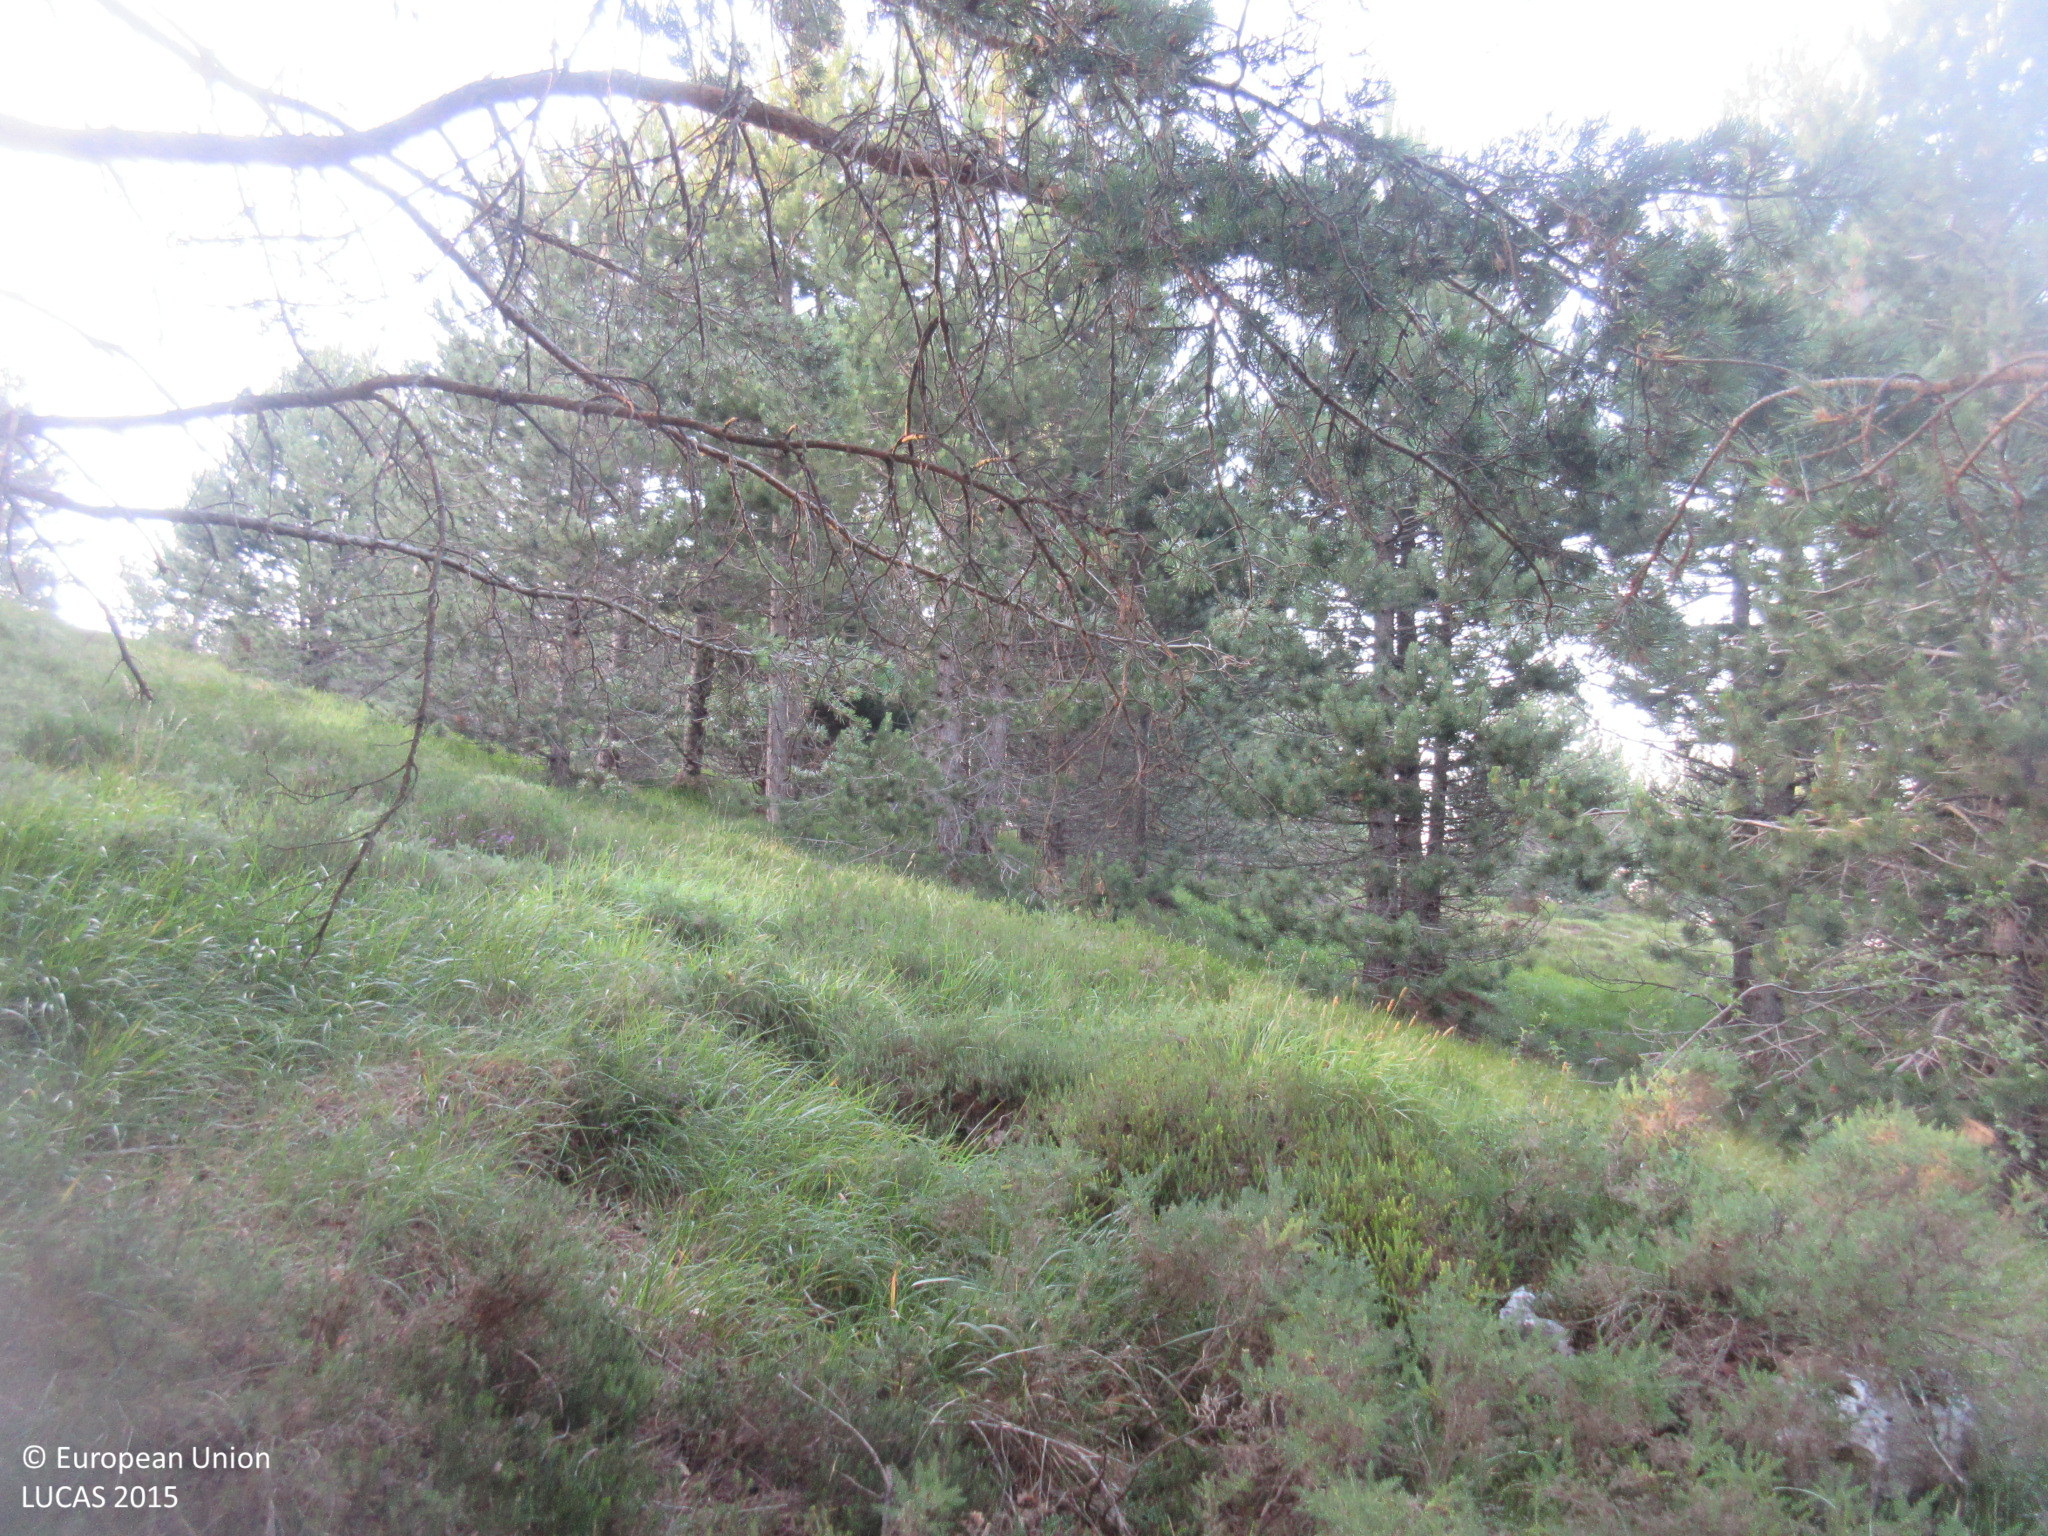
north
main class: Woodland
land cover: Pine dominated coniferous woodland
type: hemiboreal forest and nemoral coniferous forest and mixed broadleaved-coniferous forest
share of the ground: > 75 %
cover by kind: coniferous forest trees 90 %, shrubs 10 %
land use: Forestry
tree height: > 5 m
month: July
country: ES
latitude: 43.0394
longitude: -3.5305
